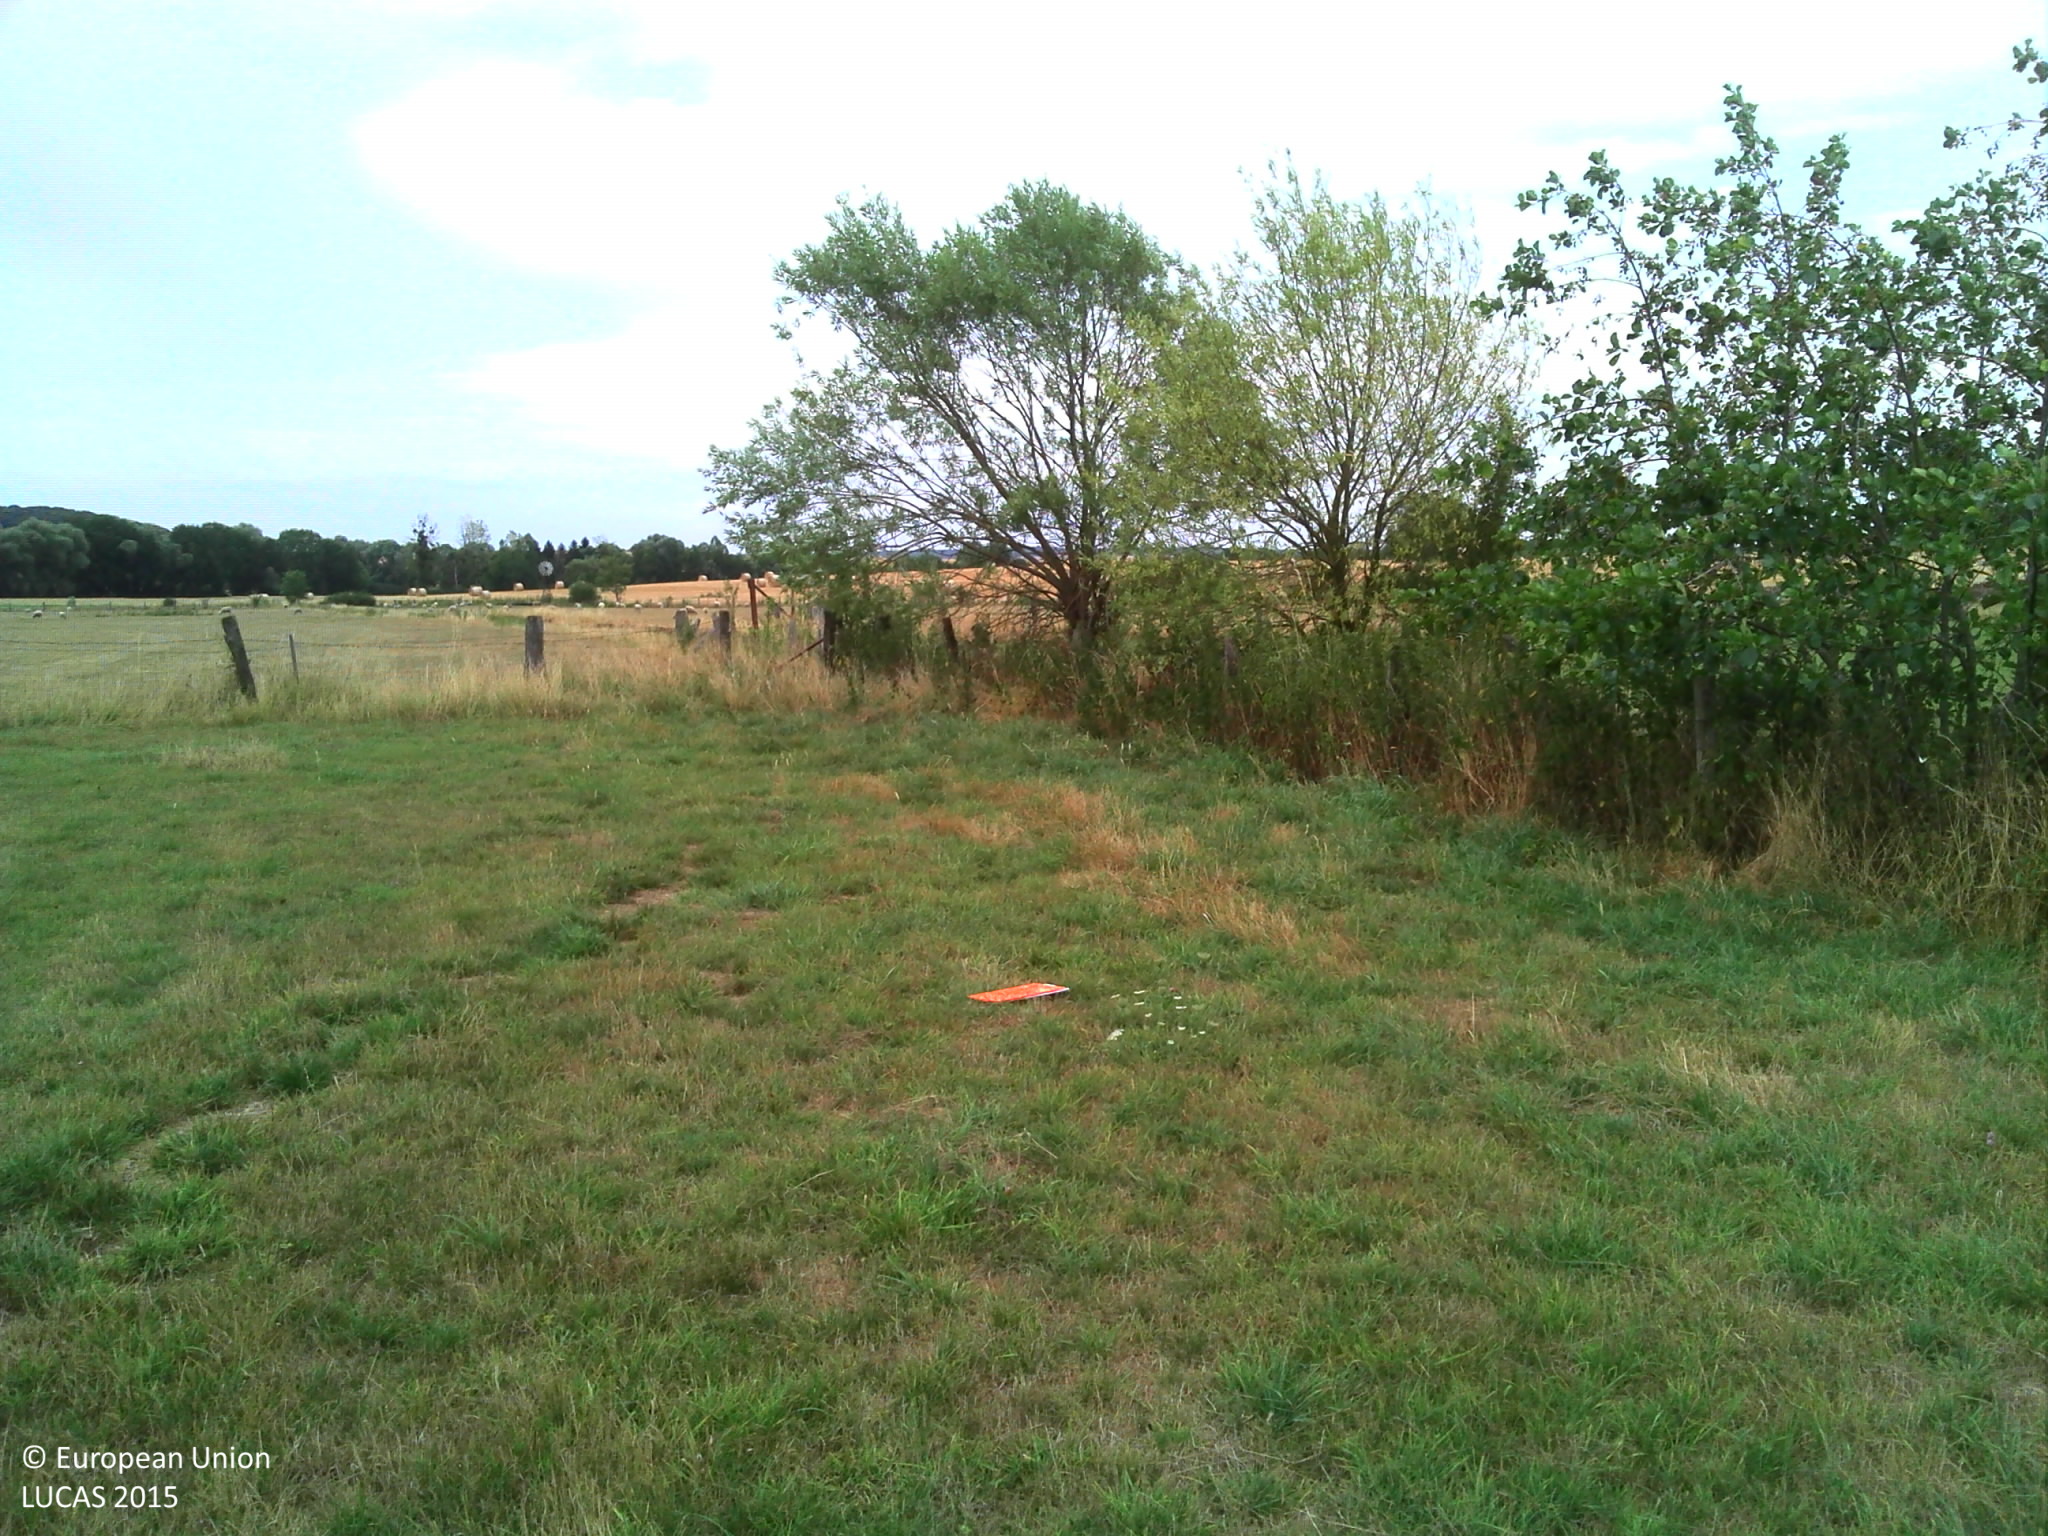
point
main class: Grassland
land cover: Grassland without tree/shrub cover
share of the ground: > 75 %
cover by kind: herbaceous plants 100 %
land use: Agriculture (excluding fallow land and kitchen gardens)
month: July
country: FR
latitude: 48.3688
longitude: 6.0450
